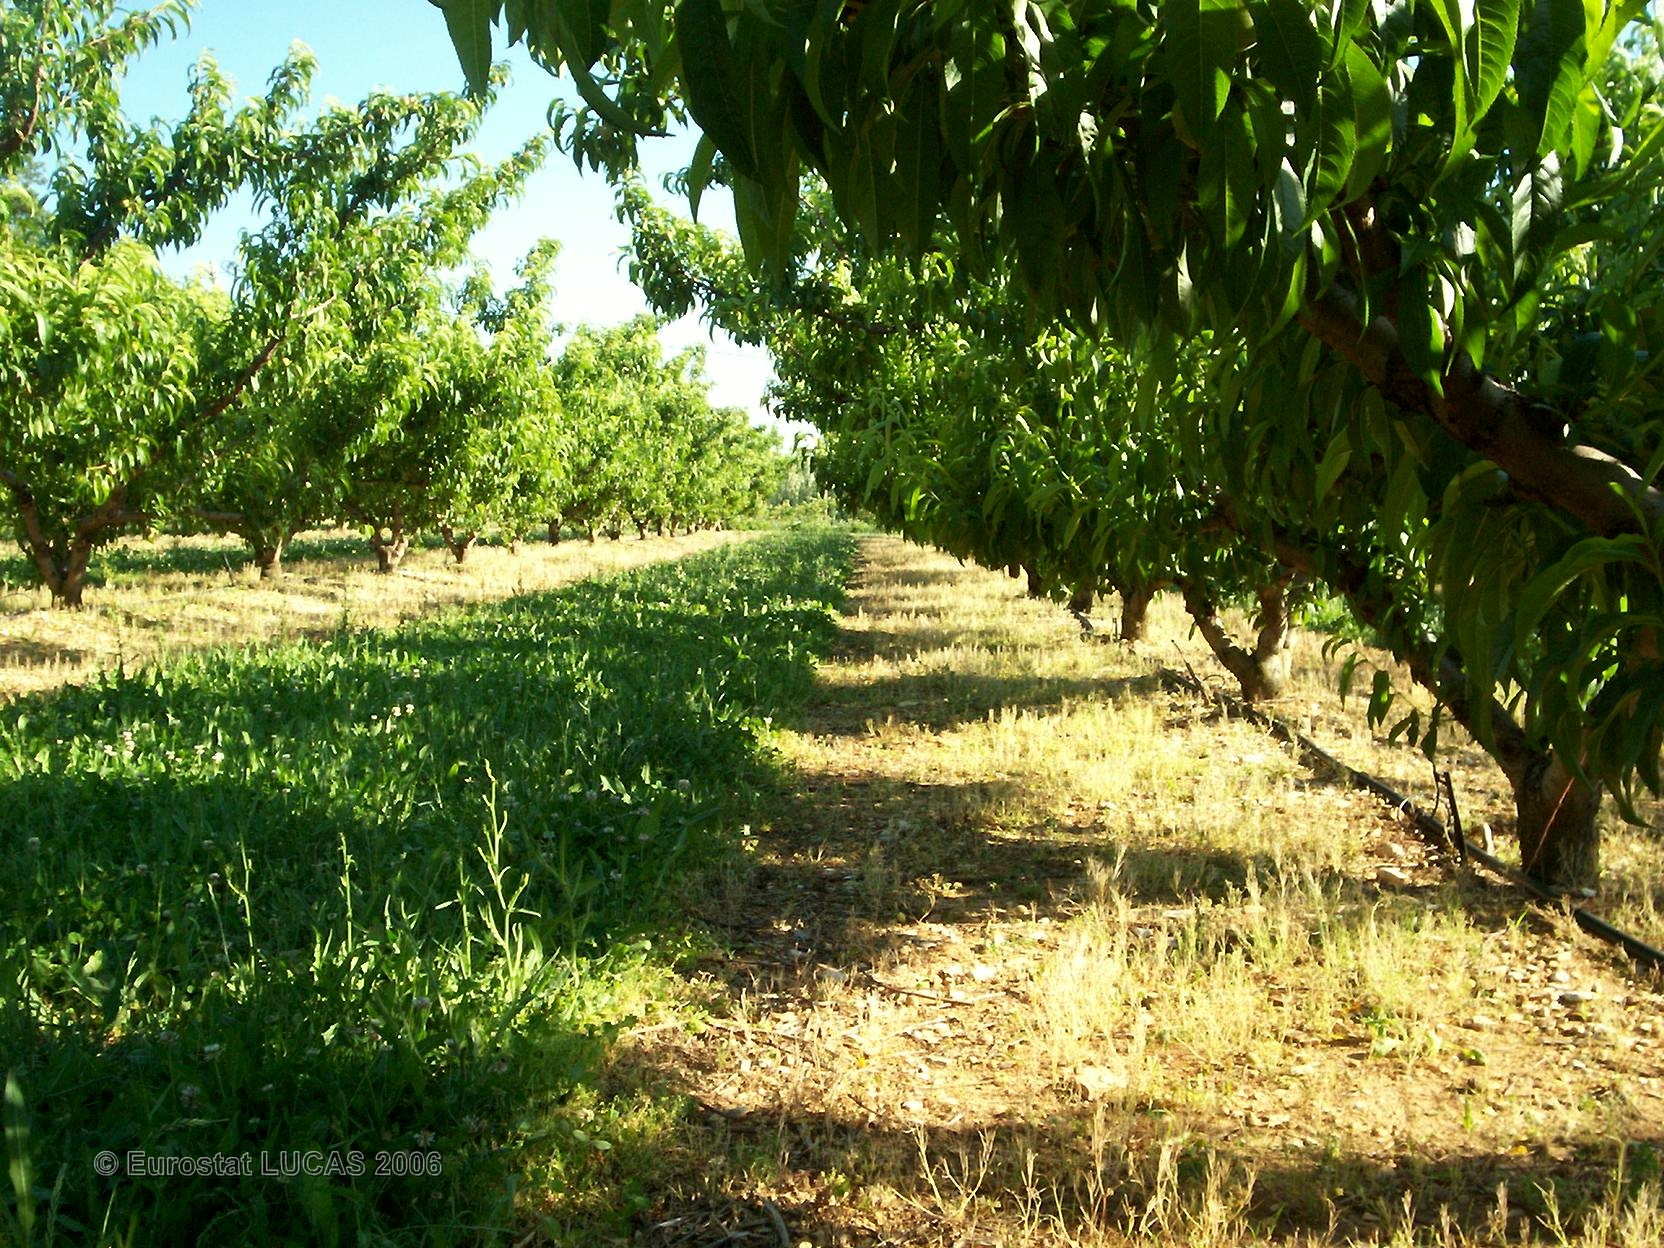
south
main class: Cropland
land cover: Other fruit trees and berries
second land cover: Grassland with sparse tree/shrub cover
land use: Agriculture (excluding fallow land and kitchen gardens)
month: May
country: FR
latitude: 44.6910
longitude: 4.8203
